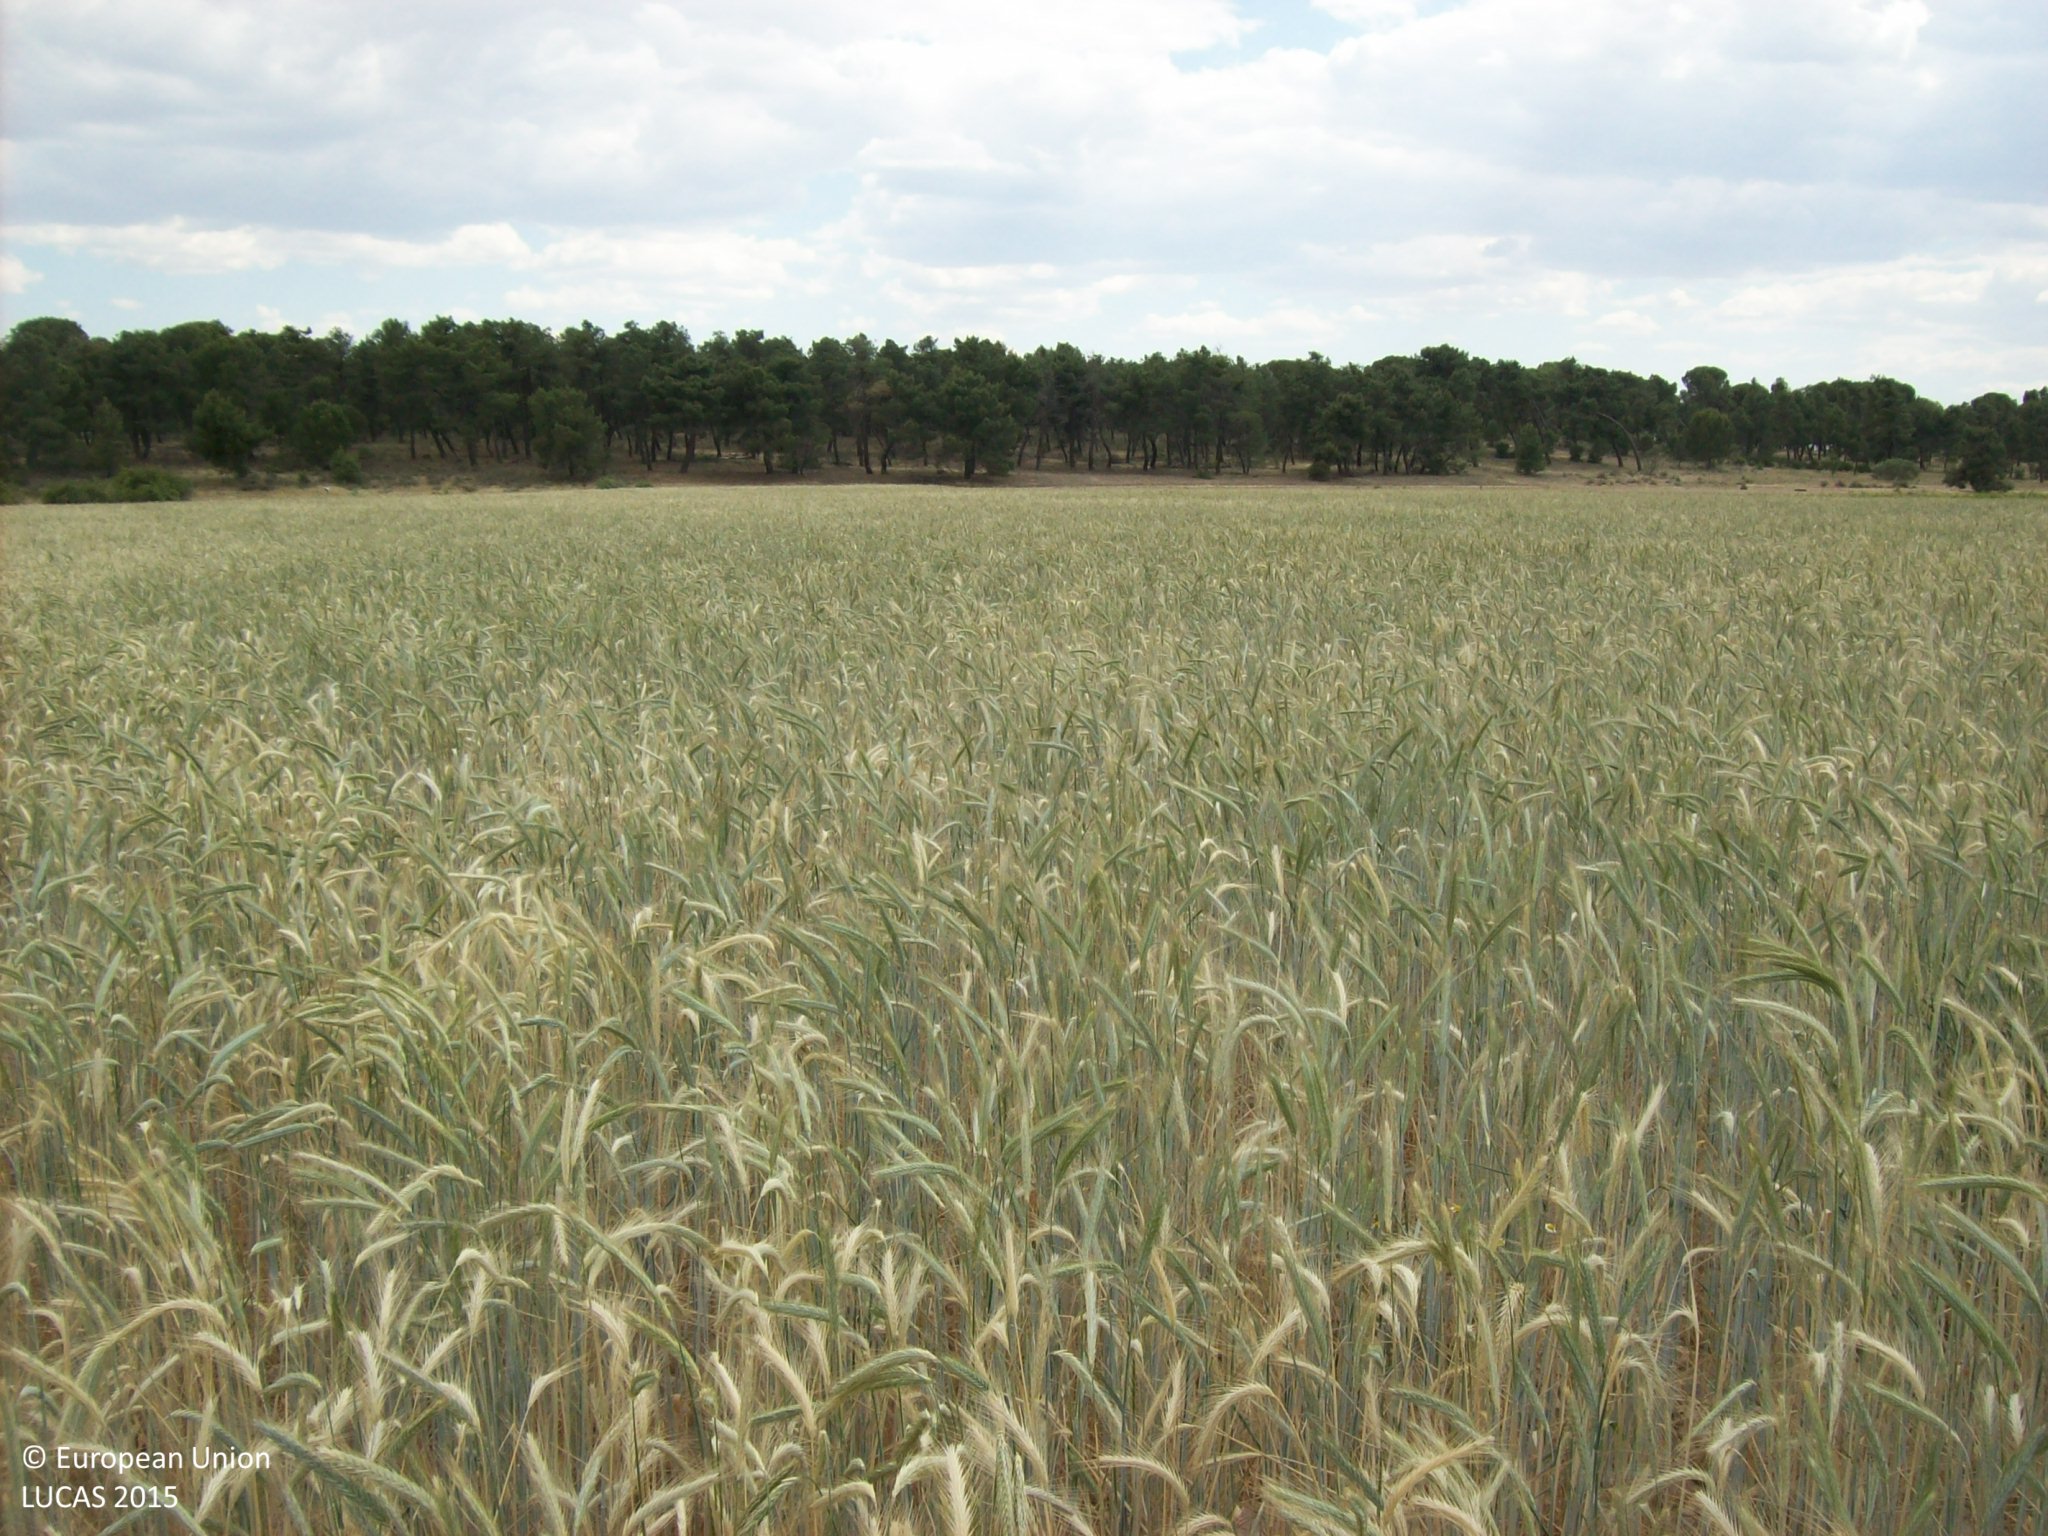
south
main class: Cropland
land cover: Rye
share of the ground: > 75 %
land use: Agriculture (excluding fallow land and kitchen gardens)
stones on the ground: 10 - 25 %
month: June
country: ES
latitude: 41.1022
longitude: -4.5498
